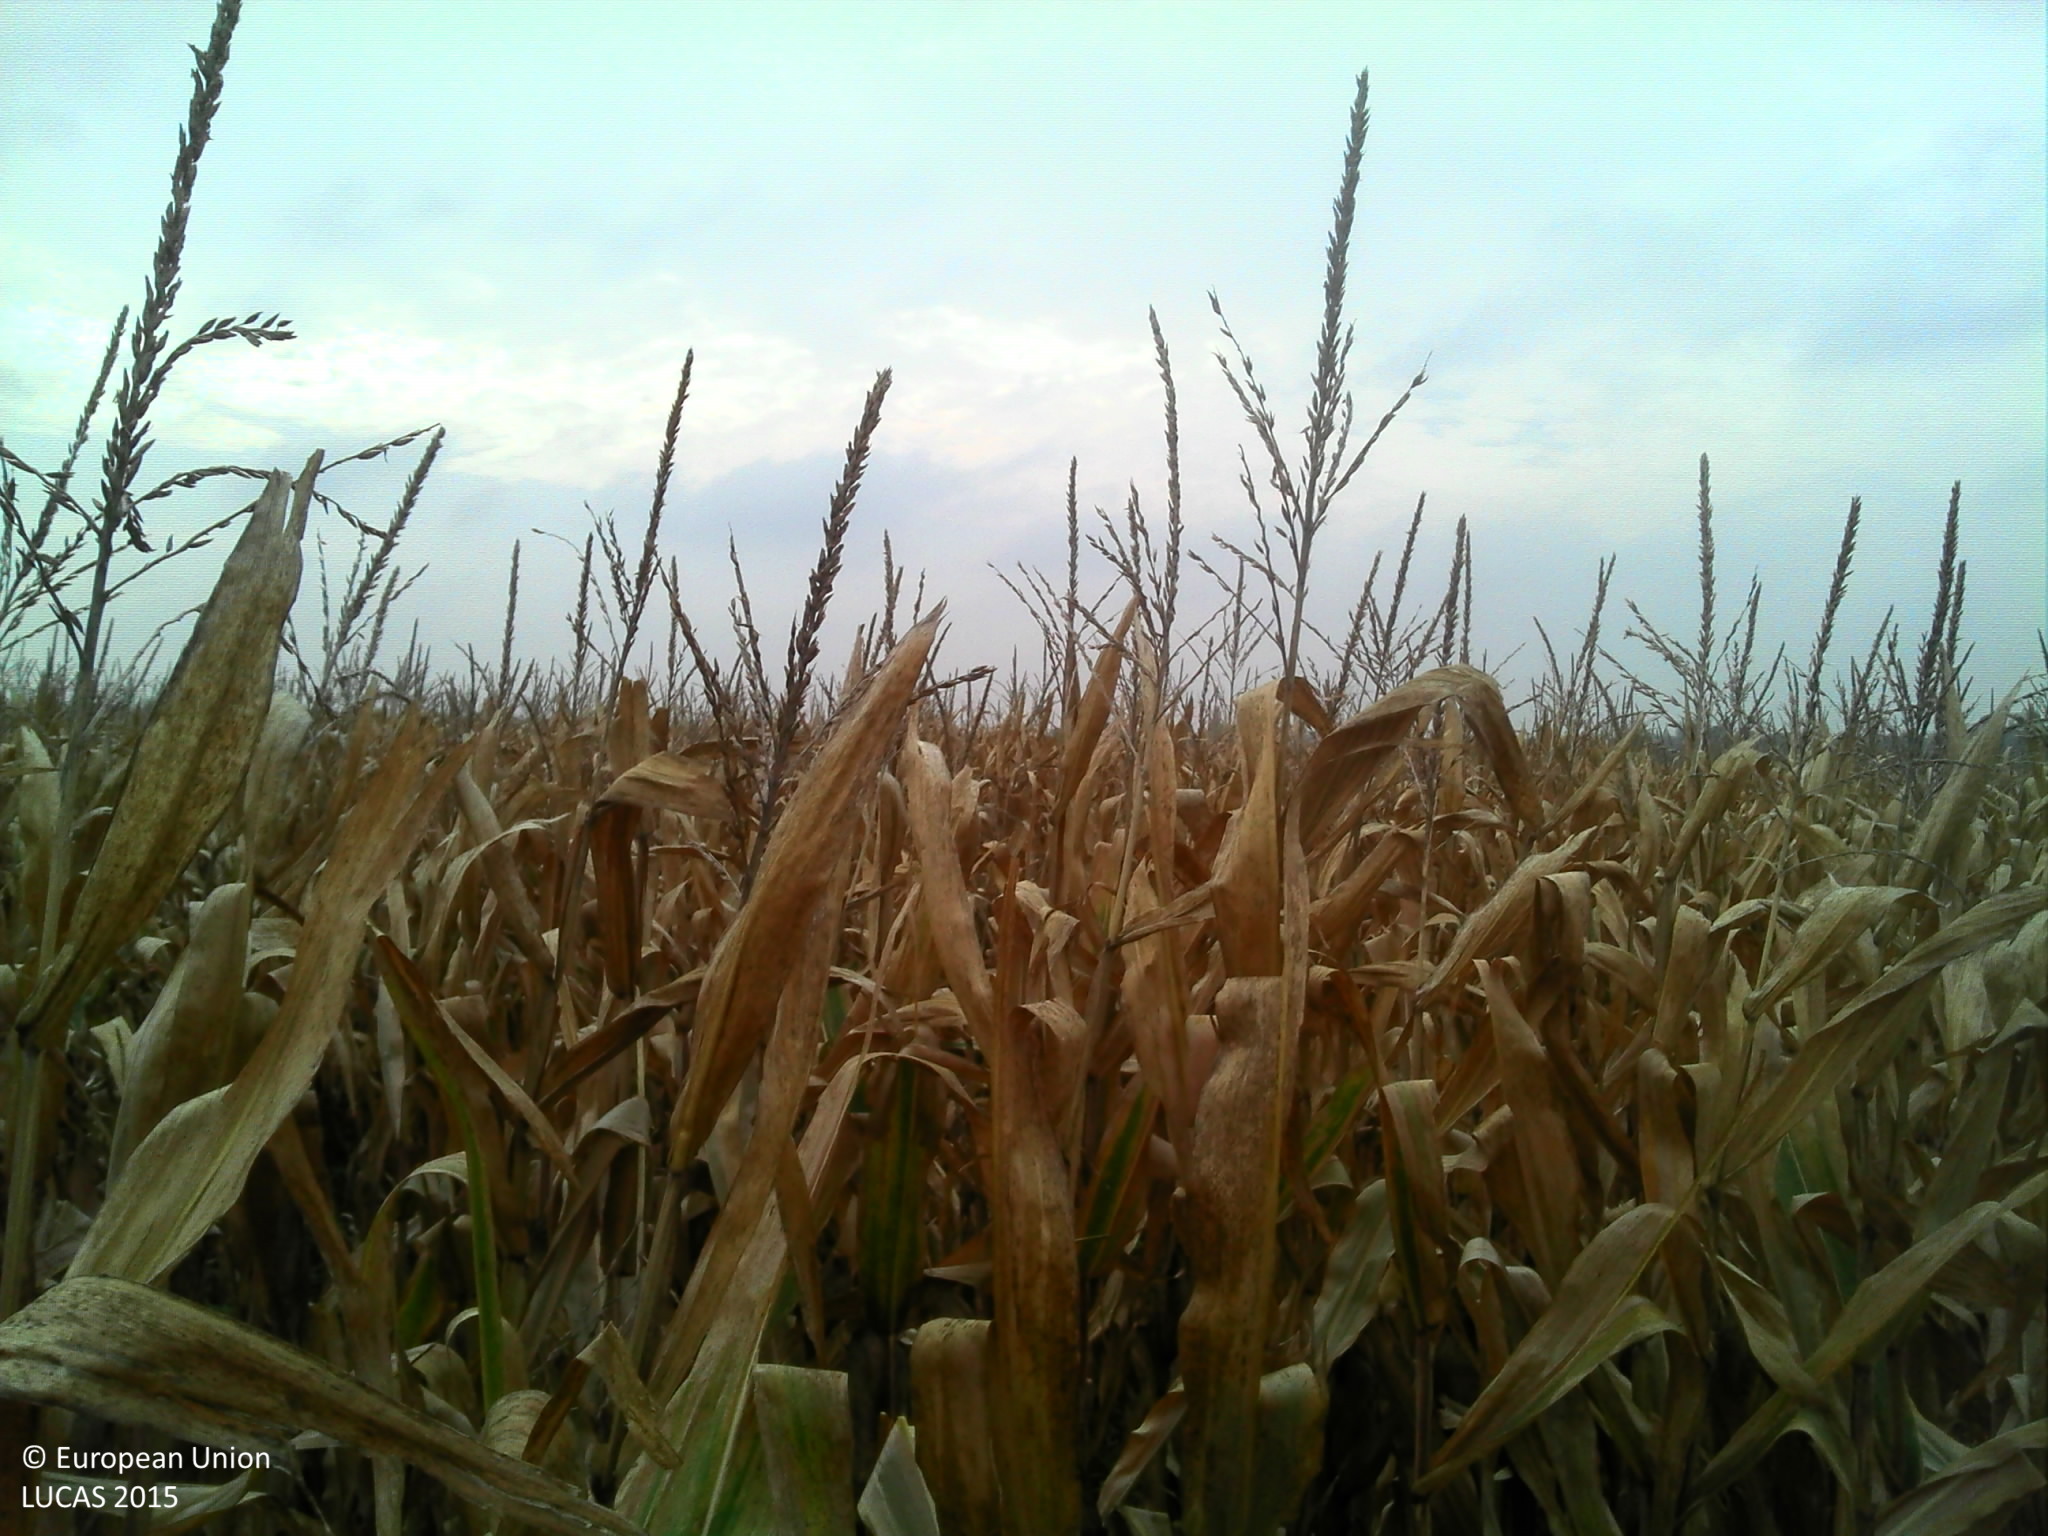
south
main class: Cropland
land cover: Maize
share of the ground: 25 - 50 %
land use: Agriculture (excluding fallow land and kitchen gardens)
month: October
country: FR
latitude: 46.4536
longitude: -1.0069
